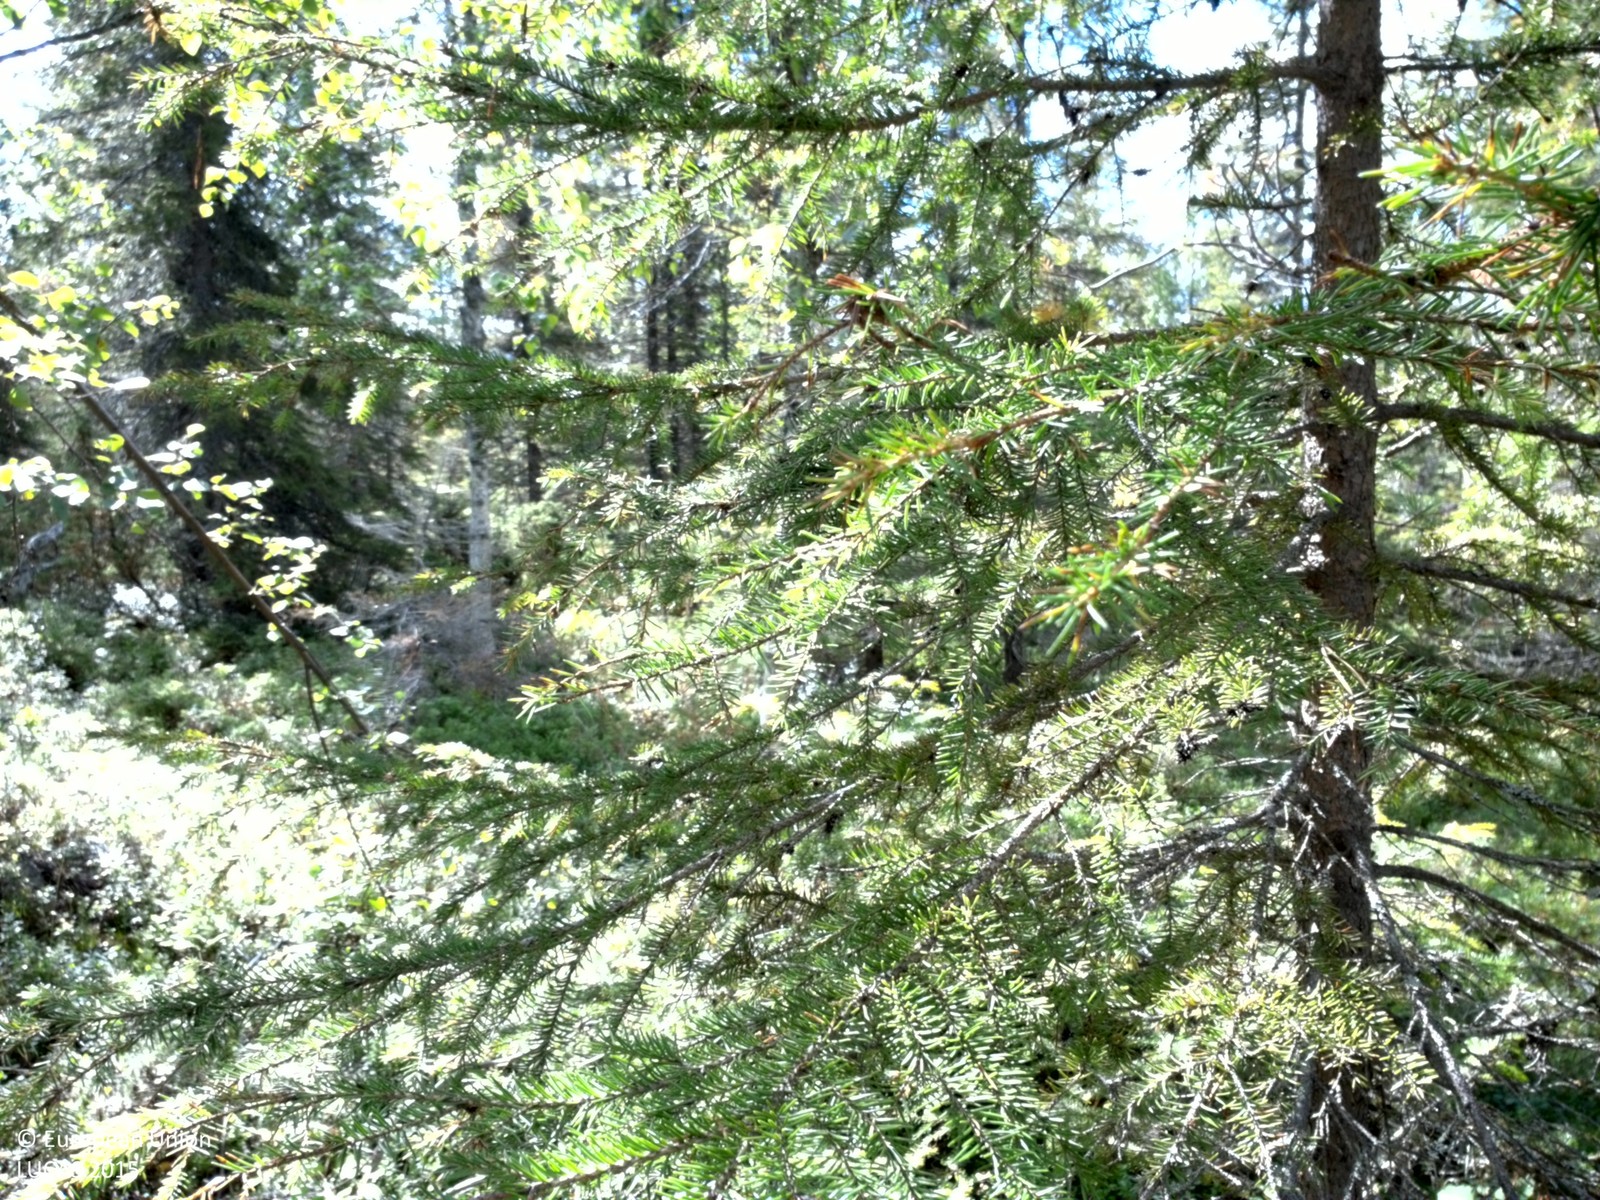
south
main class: Woodland
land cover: Pine dominated coniferous woodland
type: boreal forest
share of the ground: 25 - 50 %
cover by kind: shrubs 65 %, coniferous forest trees 30 %, broadleaved forest trees 5 %
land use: Forestry
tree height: > 5 m
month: August
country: SE
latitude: 66.1716
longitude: 22.3298
